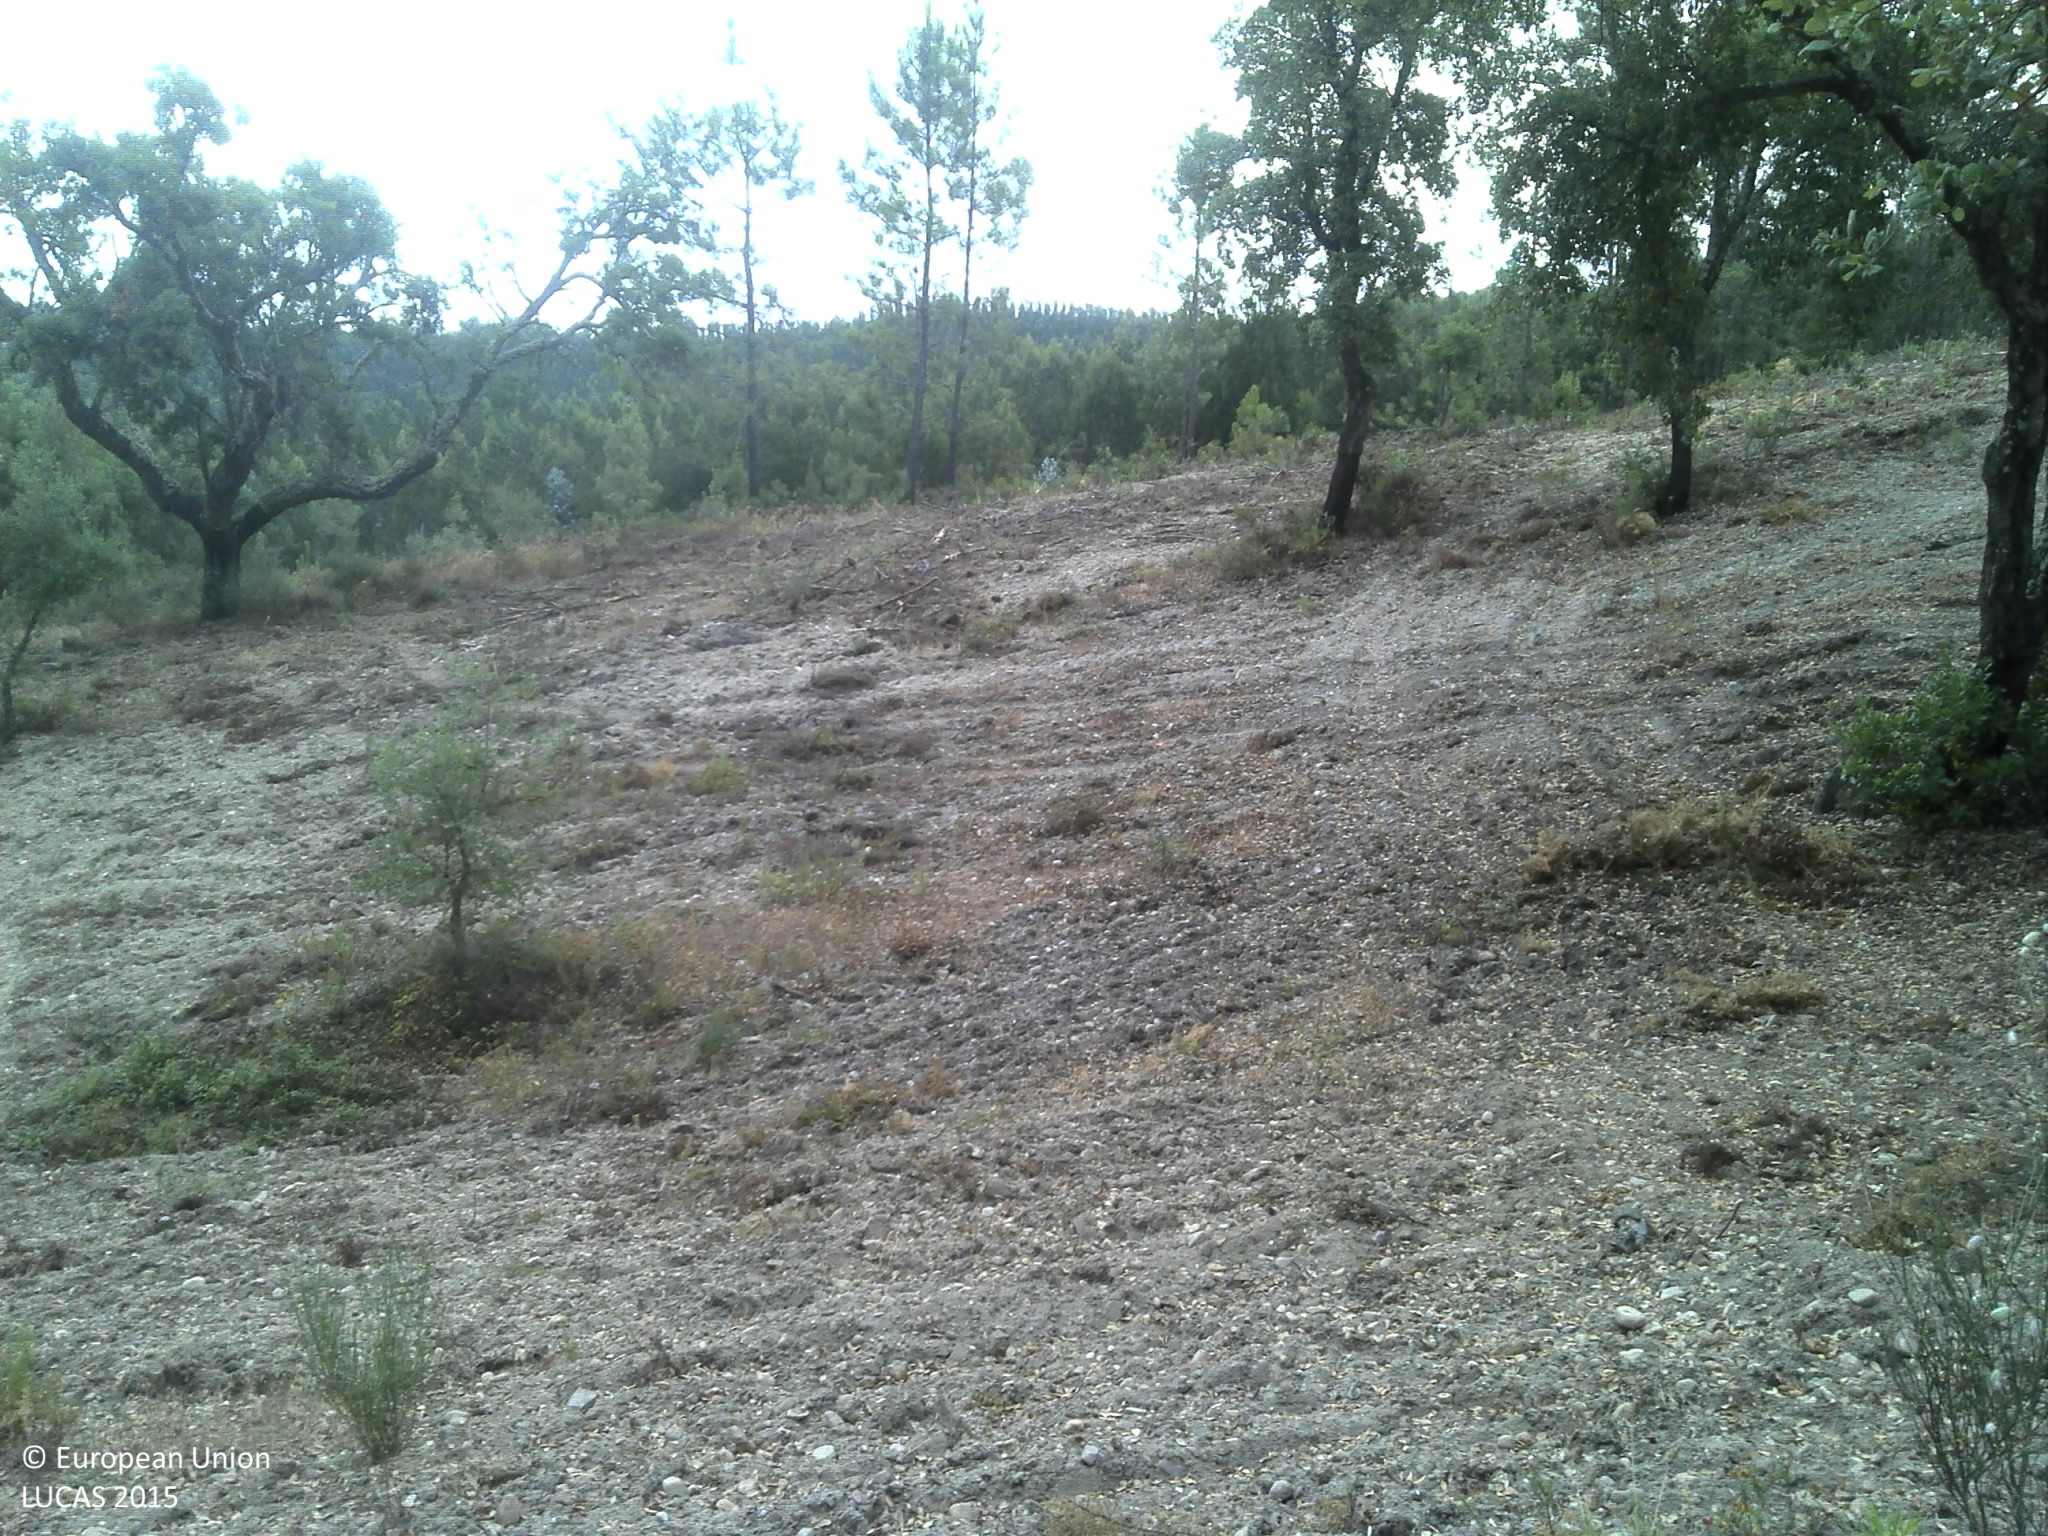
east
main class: Woodland
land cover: Broadleaved woodland
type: broadleaved evergreen forest
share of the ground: 25 - 50 %
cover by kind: broadleaved forest trees 50 %, unconsolidated bare surface 40 %, herbaceous plants 10 %
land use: Forestry
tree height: > 5 m
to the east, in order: Broadleaved woodland; Pine dominated coniferous woodland; Grass margins; Paved roads, cycling and walking lanes; Grass margins; Pine dominated coniferous woodland; Shrubland with sparse tree cover; Ditches and canals; Broadleaved woodland
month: June
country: PT
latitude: 39.3351
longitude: -8.0516
